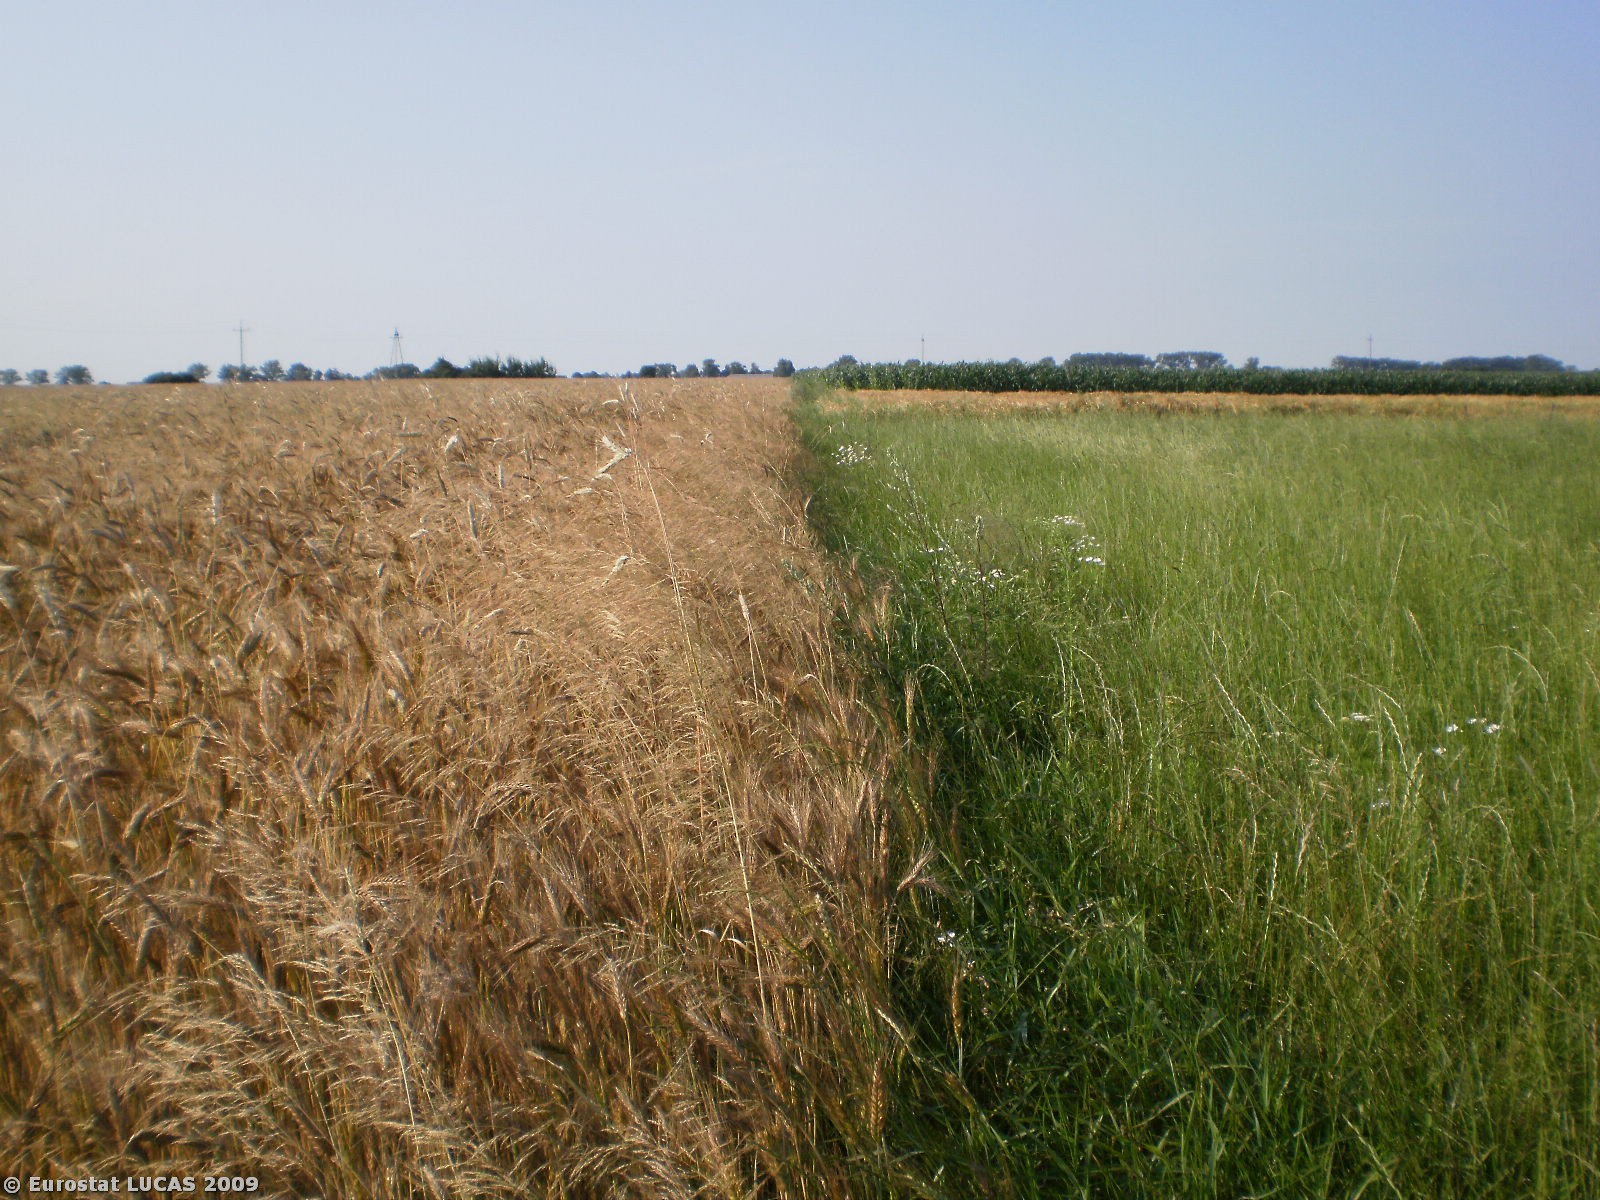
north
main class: Cropland
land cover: Triticale
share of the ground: > 75 %
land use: Agriculture (excluding fallow land and kitchen gardens)
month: July
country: PL
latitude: 52.9631
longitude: 20.8958
